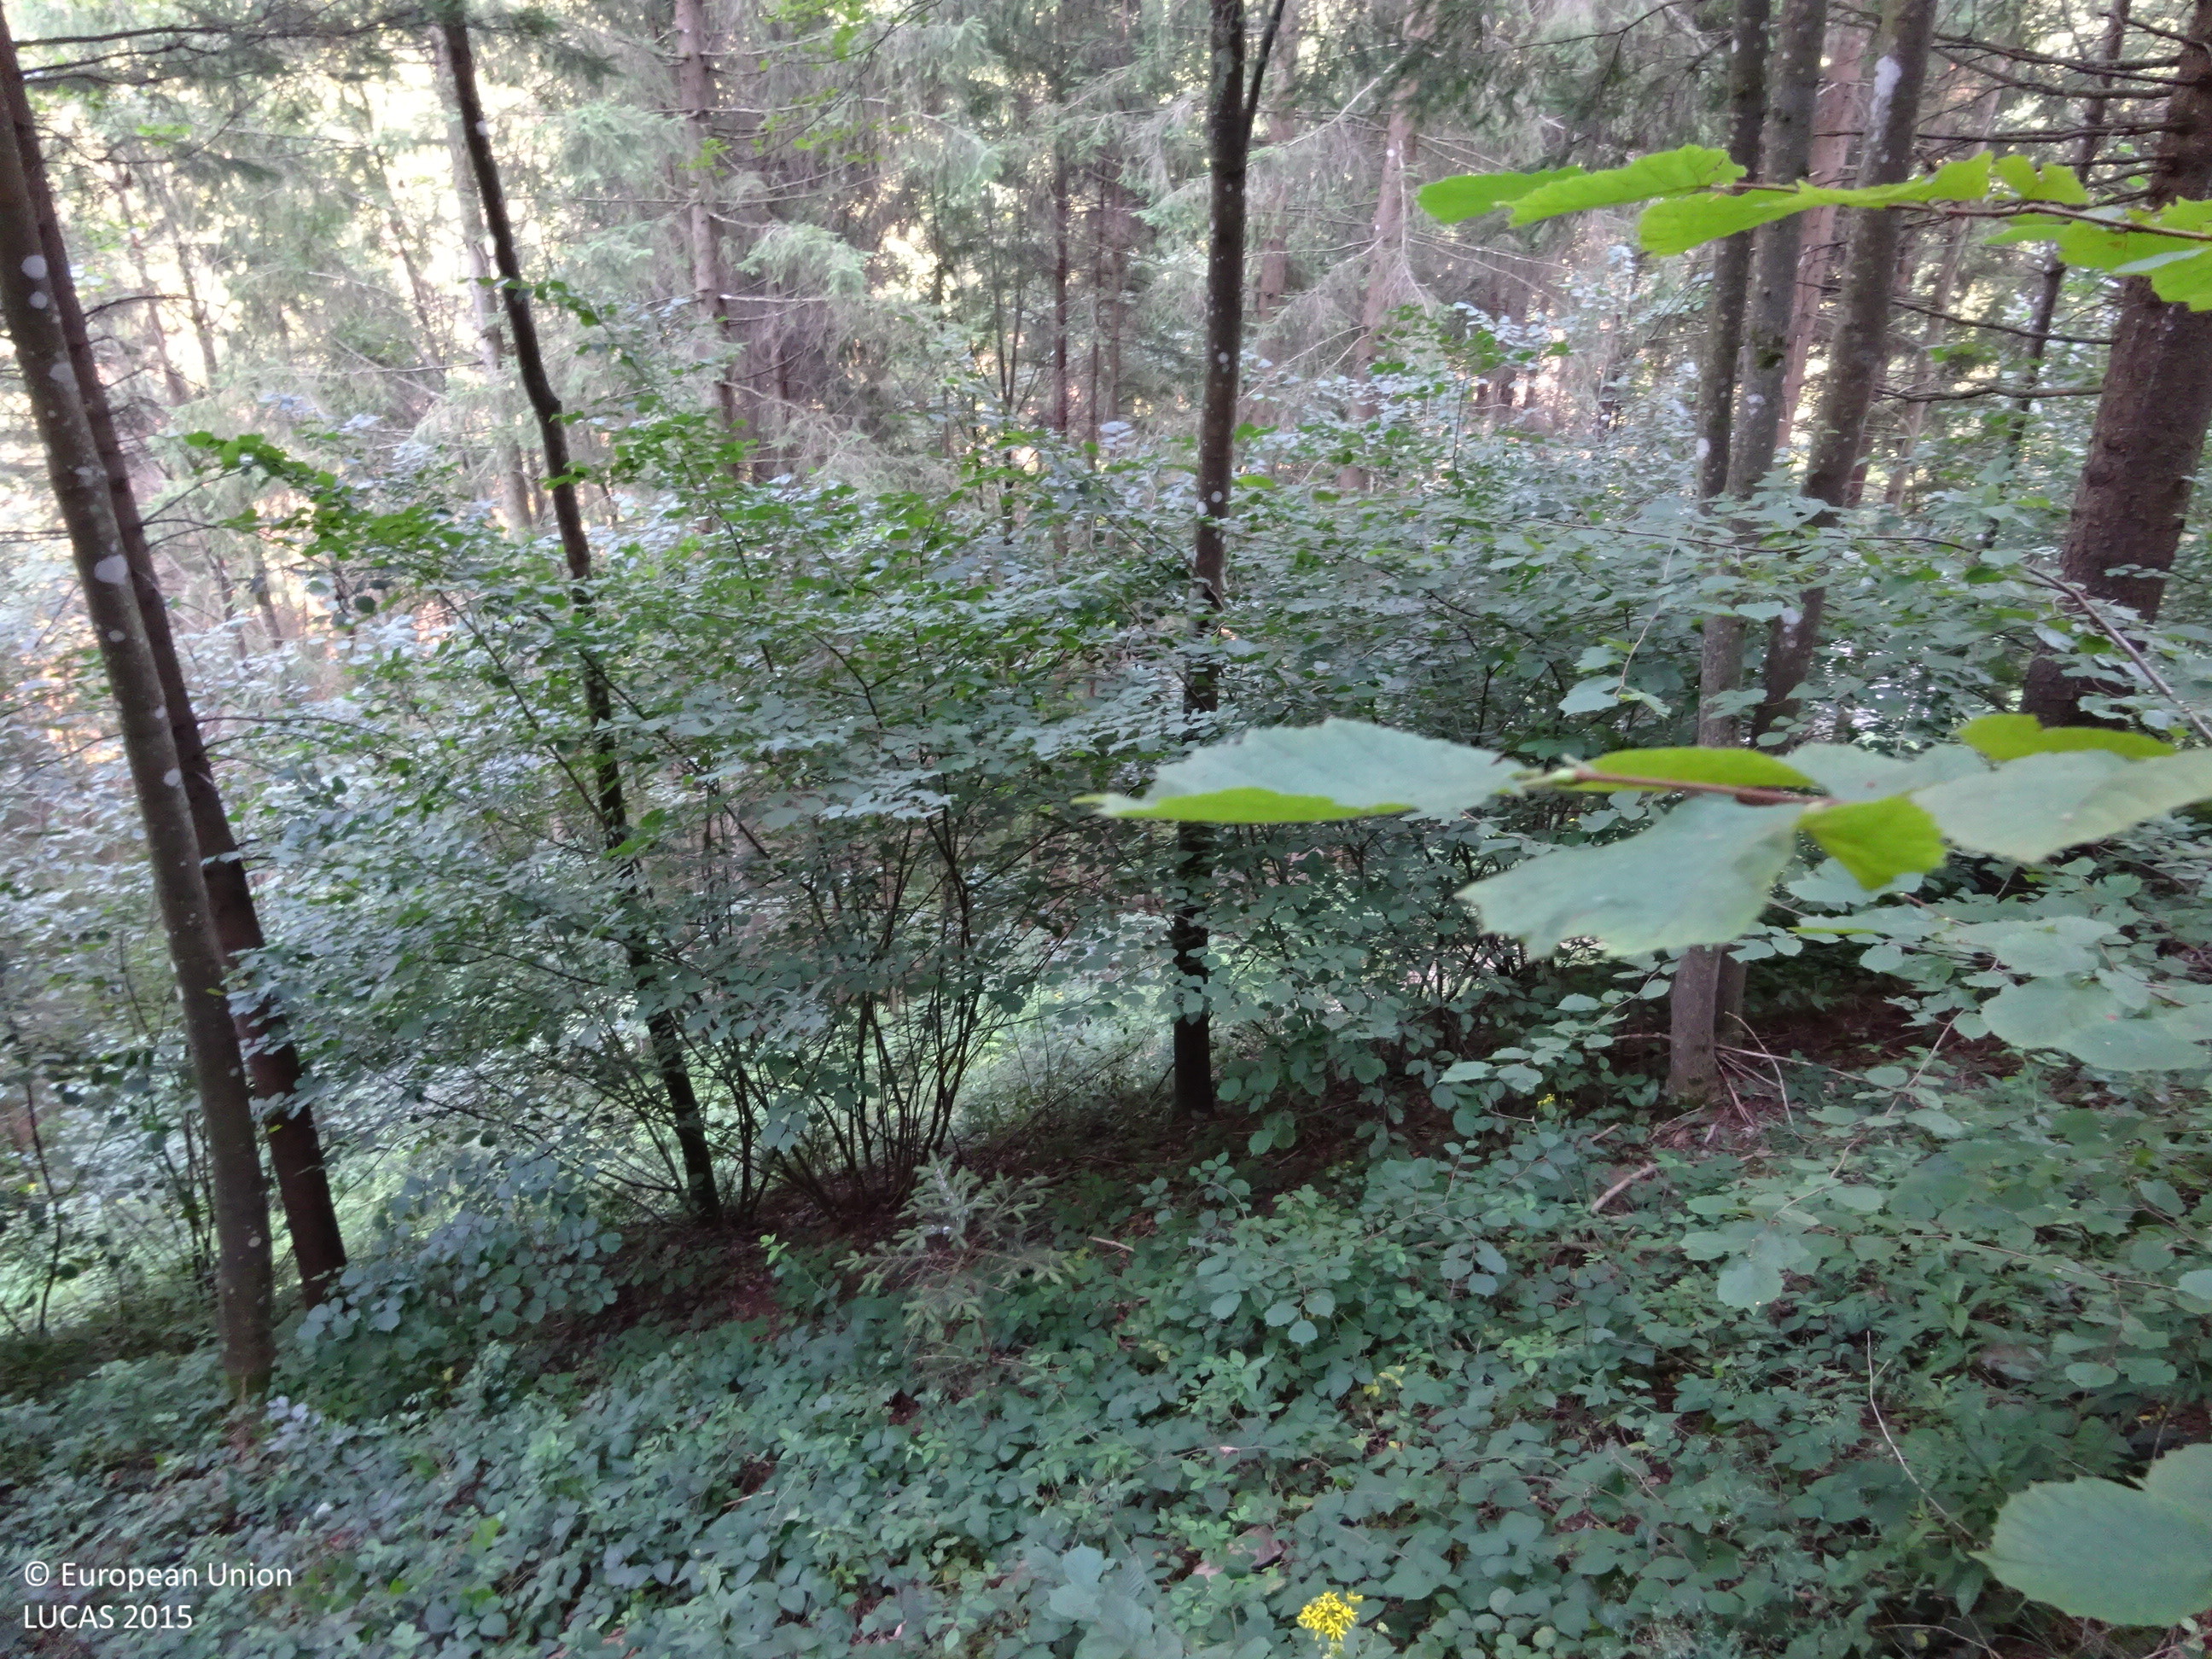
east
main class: Woodland
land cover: Spruce dominated mixed woodland
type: alpine coniferous forest
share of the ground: > 75 %
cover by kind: coniferous forest trees 50 %, broadleaved forest trees 40 %, shrubs 10 %
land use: Forestry
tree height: > 5 m
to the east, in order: Spruce dominated mixed woodland; Tracks; Spruce dominated coniferous woodland; Tracks; Spruce dominated coniferous woodland; Rivers and streams; Spruce dominated coniferous woodland; Spruce dominated mixed woodland; Tracks; Broadleaved woodland; Grassland without tree/shrub cover; Shrubland with sparse tree cover; Fences; Grassland without tree/shrub cover
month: August
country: AT
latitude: 47.4116
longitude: 15.9791
